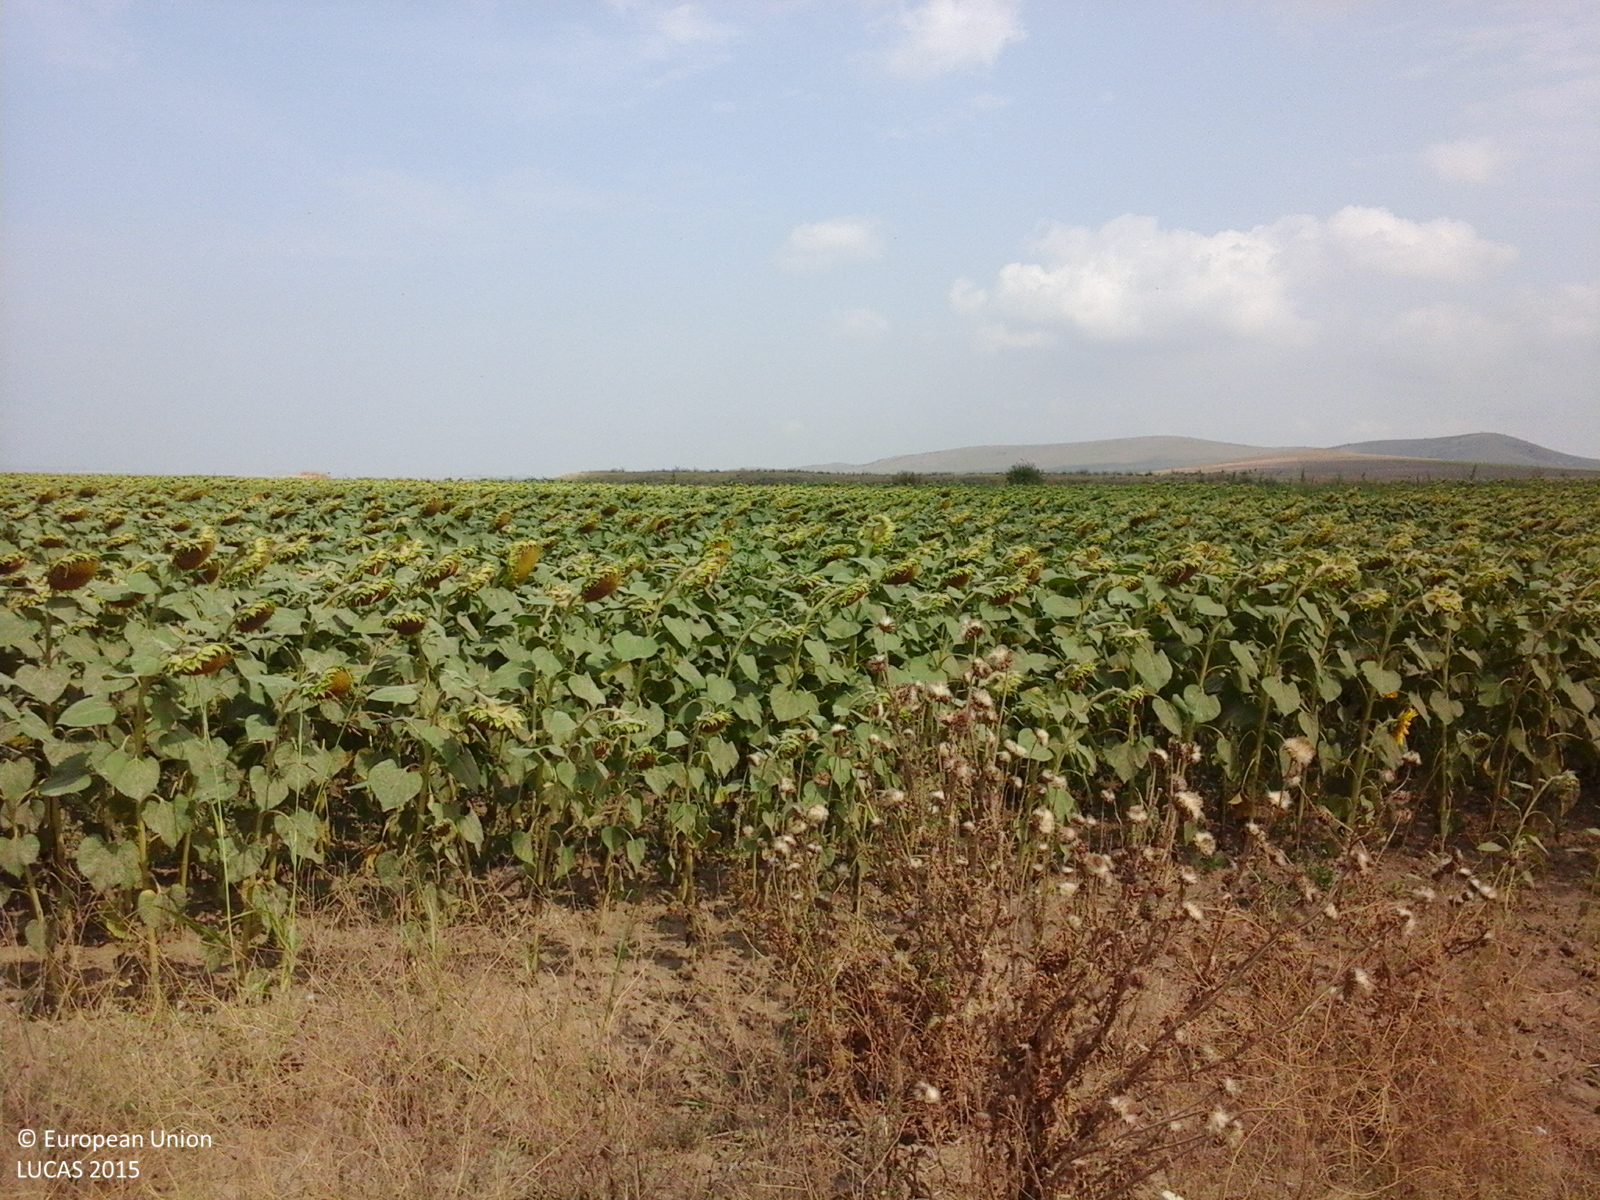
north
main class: Cropland
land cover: Sunflower
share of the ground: > 75 %
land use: Agriculture (excluding fallow land and kitchen gardens)
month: July
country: RO
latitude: 45.0410
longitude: 28.7615
